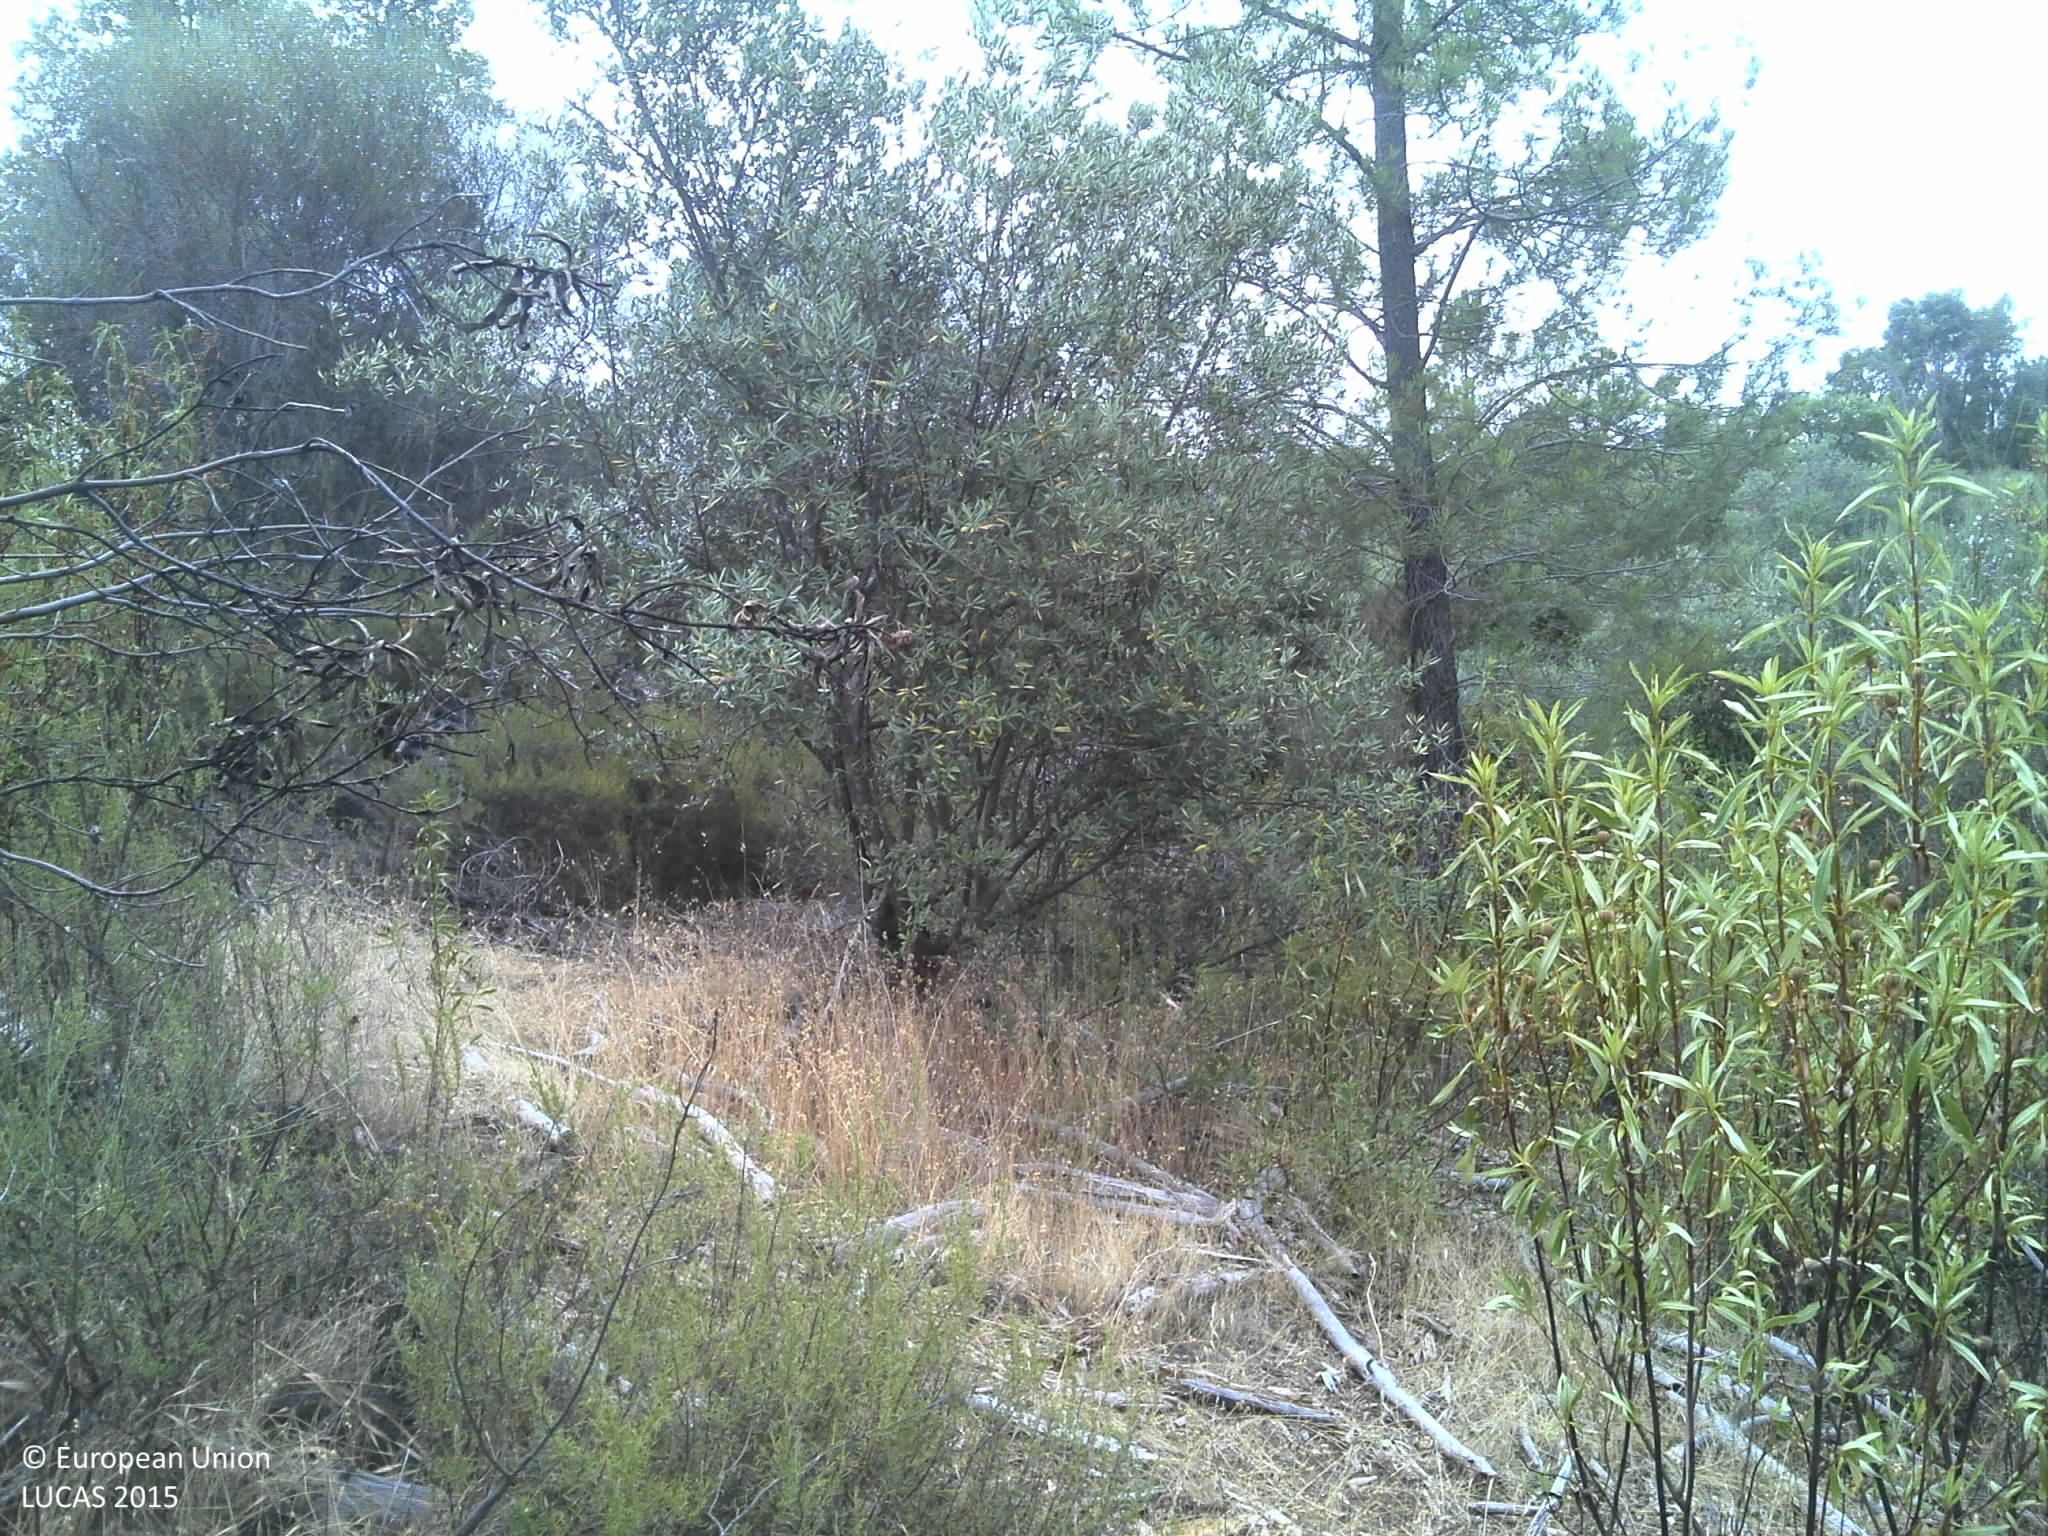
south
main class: Woodland
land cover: Pine dominated coniferous woodland
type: coniferous forest of the mediterranean region
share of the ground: 25 - 50 %
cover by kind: coniferous forest trees 45 %, shrubs 40 %, herbaceous plants 5 %, unconsolidated bare surface 5 %
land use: Forestry
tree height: > 5 m
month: July
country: PT
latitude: 39.8465
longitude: -7.3820
